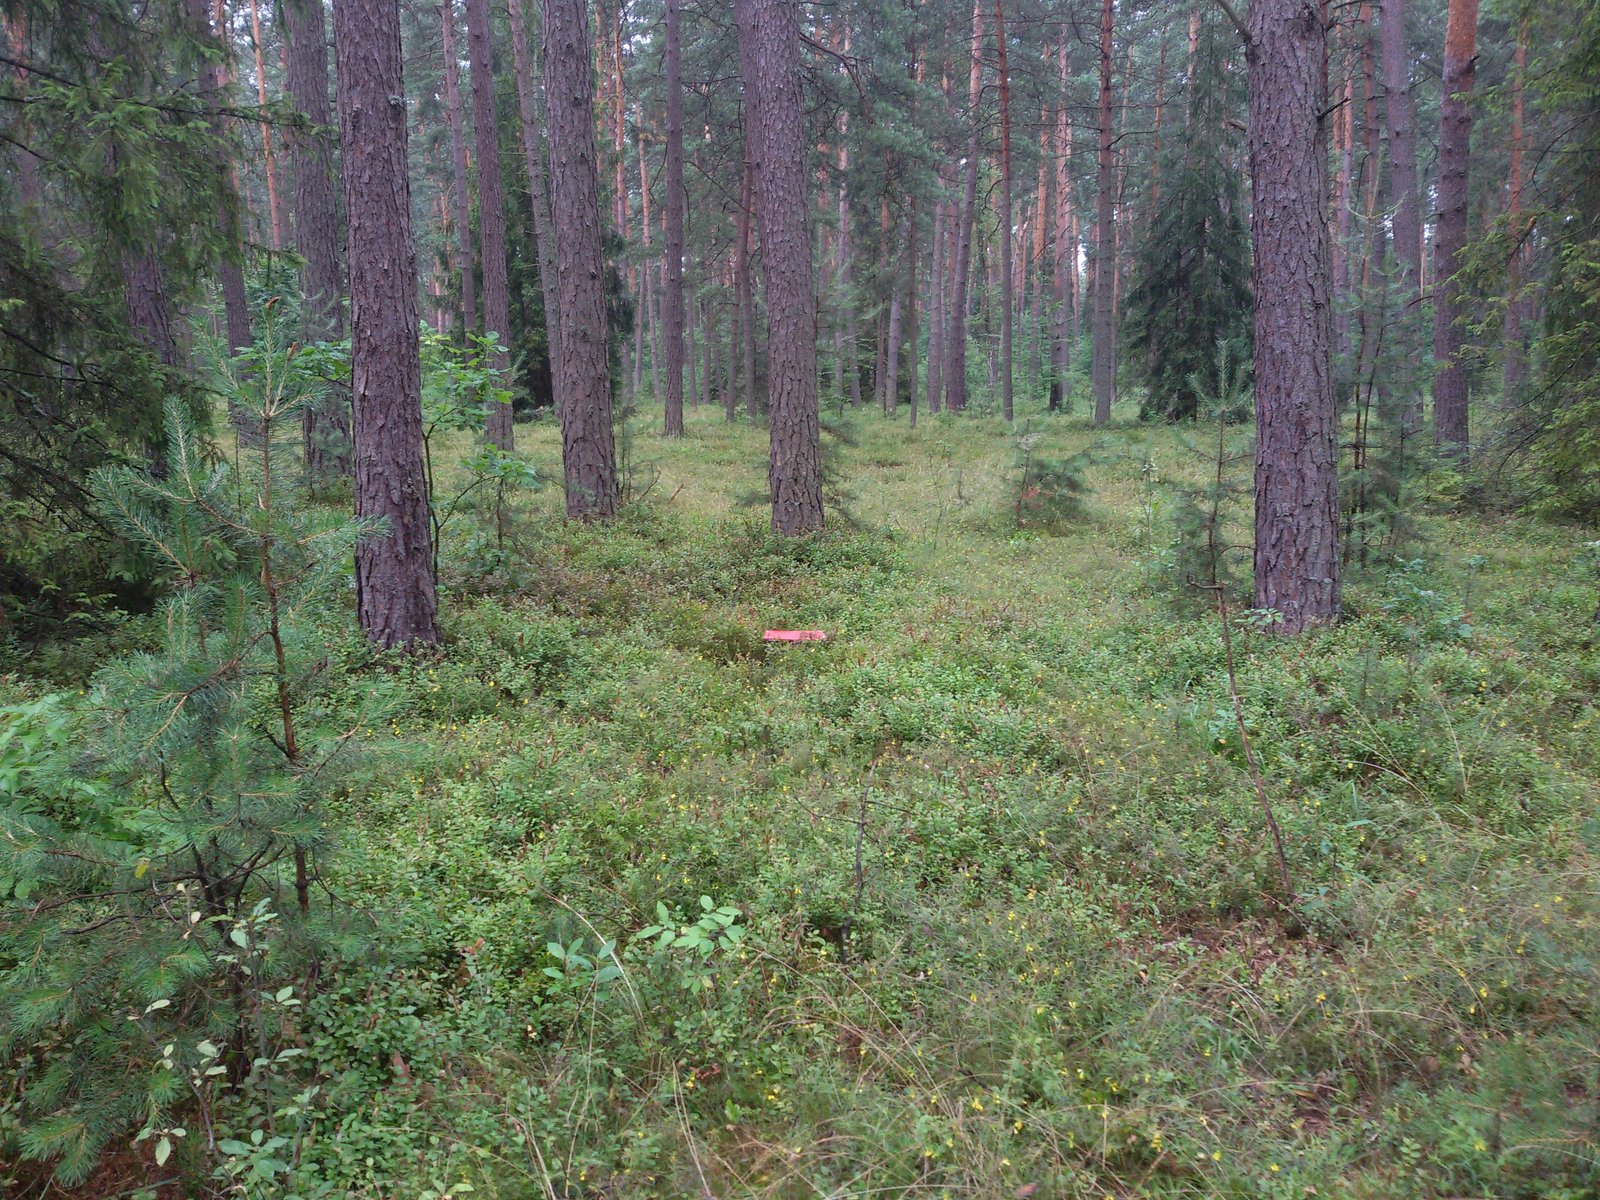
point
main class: Woodland
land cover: Pine dominated coniferous woodland
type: hemiboreal forest and nemoral coniferous forest and mixed broadleaved-coniferous forest
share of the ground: > 75 %
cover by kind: coniferous forest trees 75 %, shrubs 10 %, herbaceous plants 10 %, broadleaved forest trees 5 %
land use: Forestry
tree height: > 5 m
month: July
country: PL
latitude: 50.2298
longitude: 21.5603
